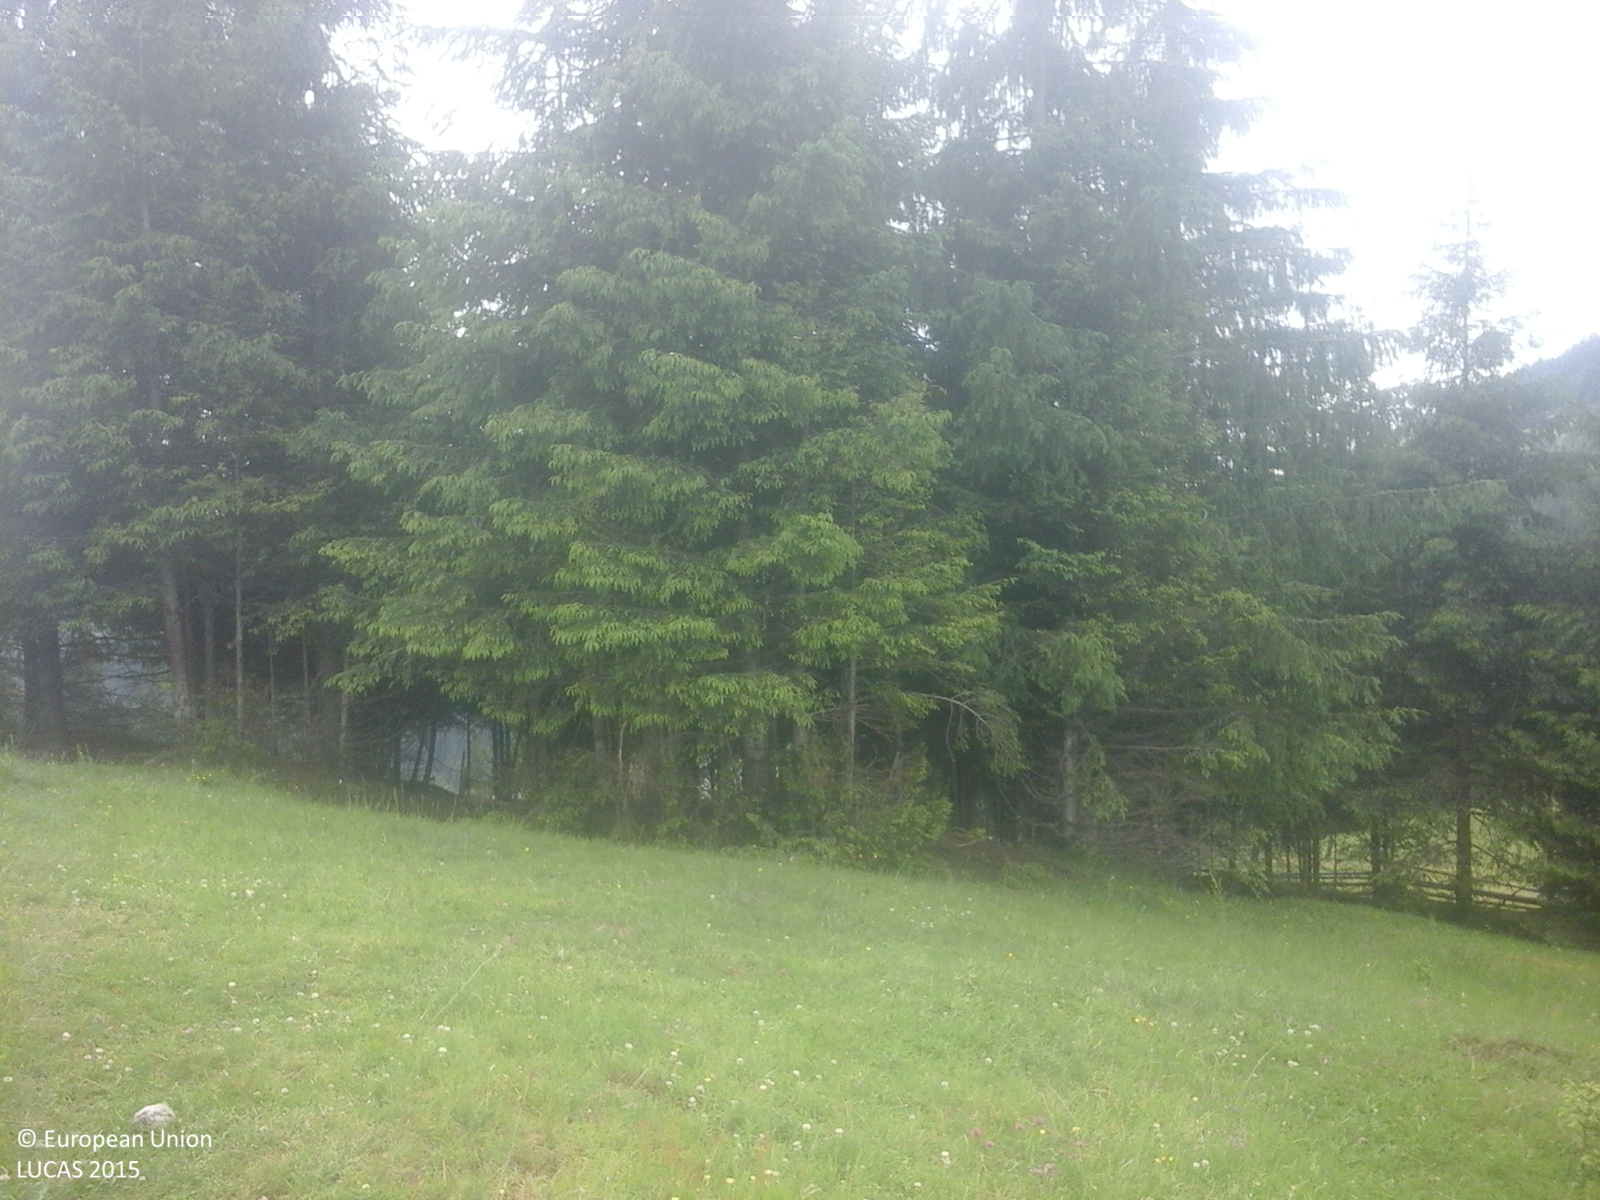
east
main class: Grassland
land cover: Grassland without tree/shrub cover
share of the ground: > 75 %
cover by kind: herbaceous plants 100 %
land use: Agriculture (excluding fallow land and kitchen gardens)
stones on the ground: < 10 %
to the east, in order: Grassland without tree/shrub cover; Spruce dominated coniferous woodland; Grassland with sparse tree/shrub cover; Tracks; Grass margins; Fences; Grassland without tree/shrub cover; Fences; Grassland without tree/shrub cover; Spruce dominated coniferous woodland
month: June
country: RO
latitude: 47.3321
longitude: 25.2883
